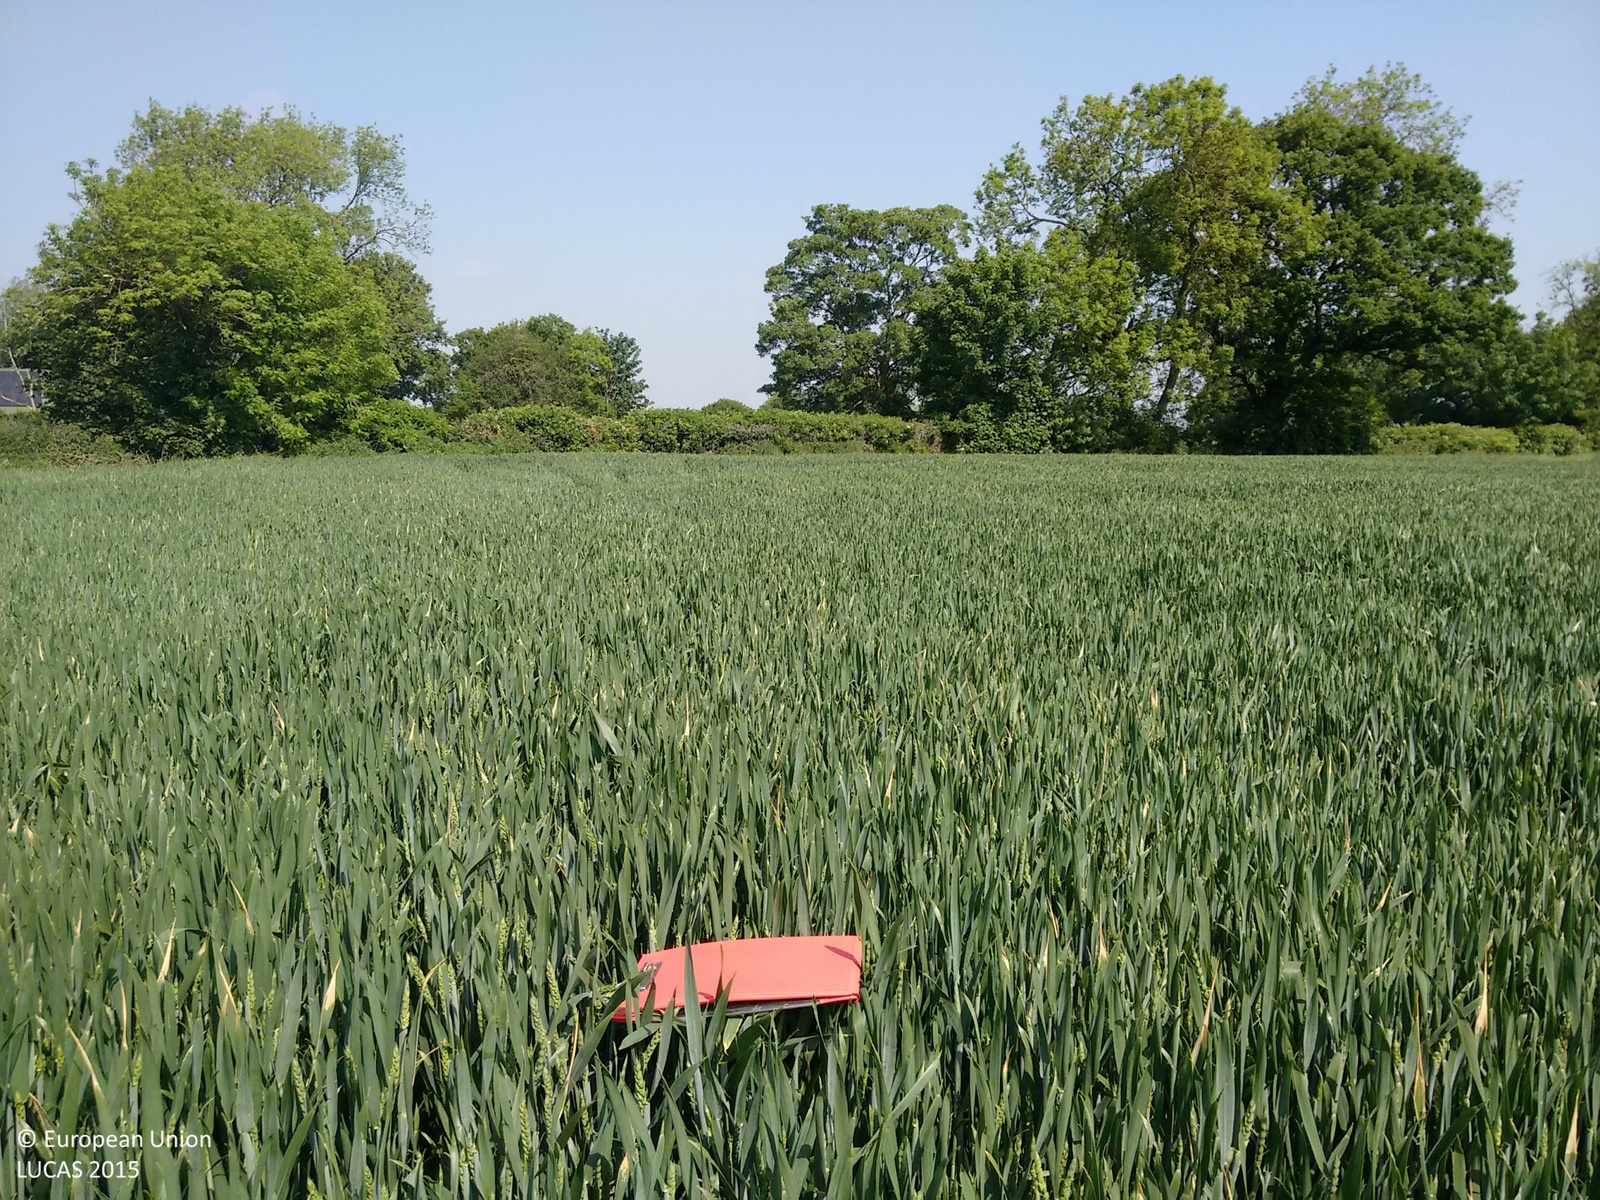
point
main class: Cropland
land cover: Common wheat
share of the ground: > 75 %
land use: Agriculture (excluding fallow land and kitchen gardens)
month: June
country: GB
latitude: 53.9328
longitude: -1.2099
